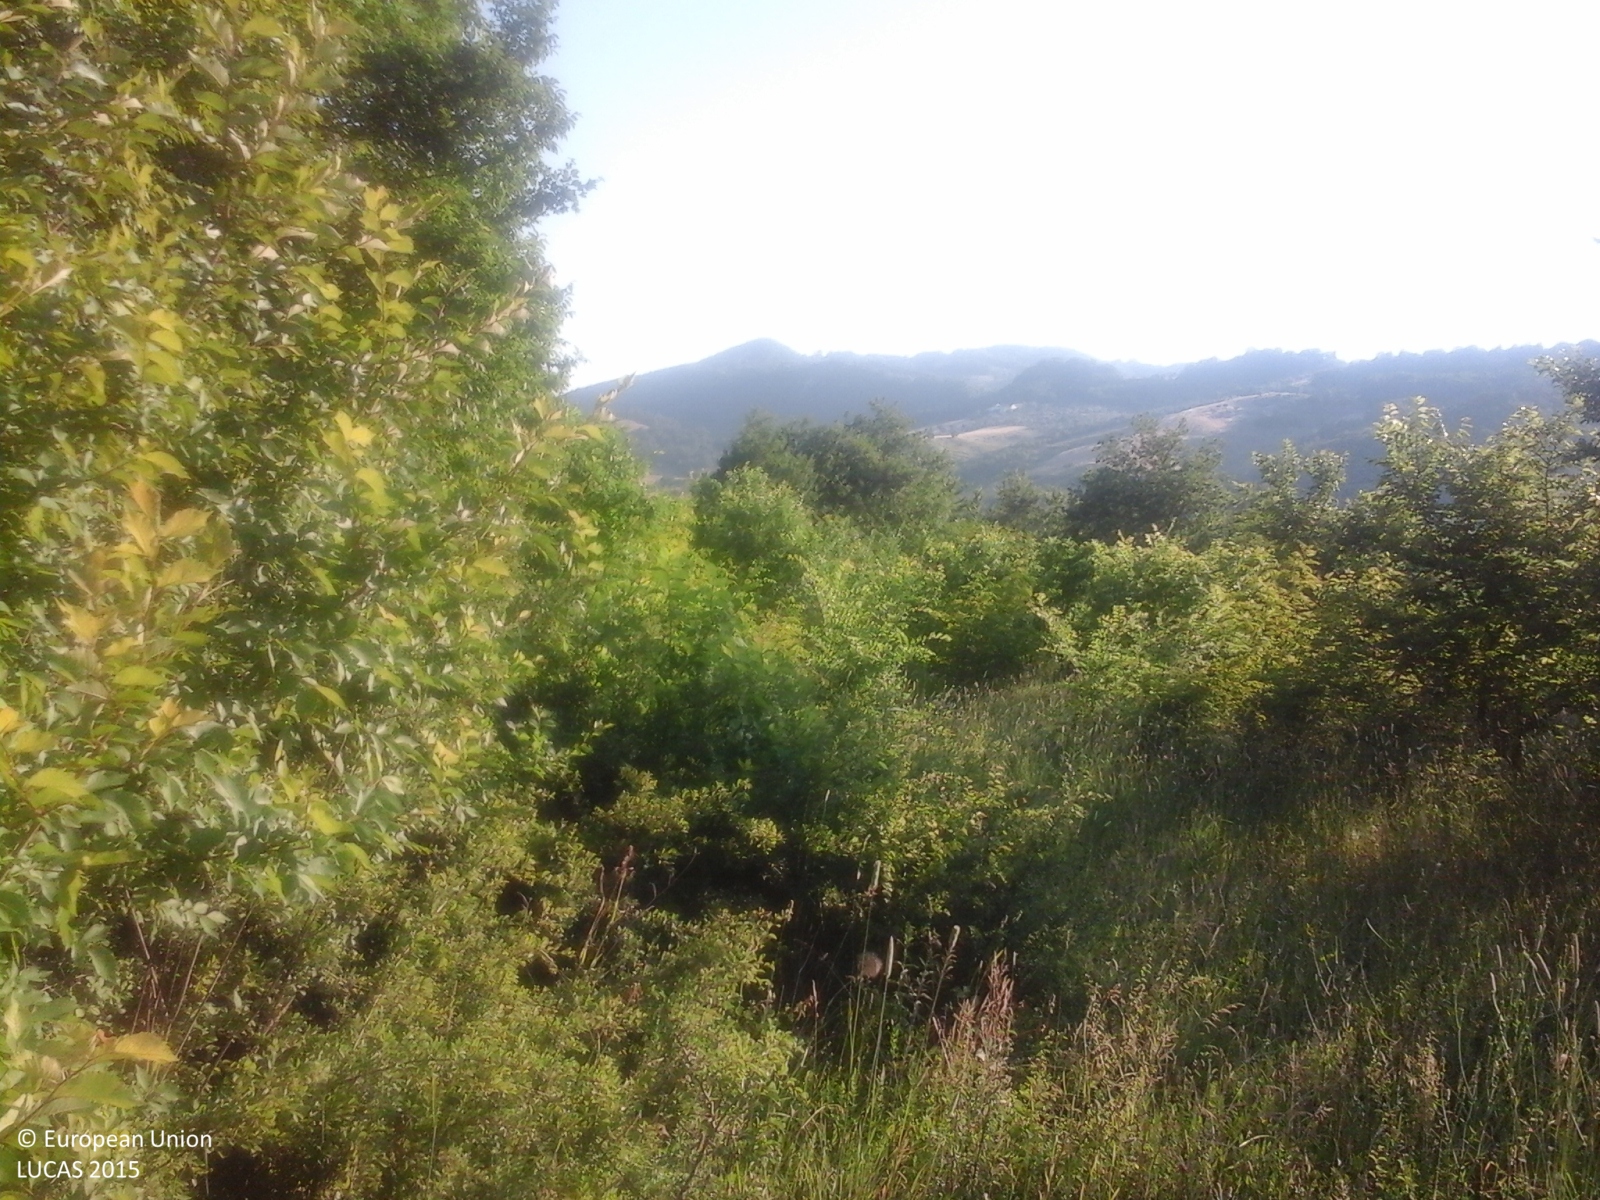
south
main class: Grassland
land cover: Grassland without tree/shrub cover
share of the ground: 25 - 50 %
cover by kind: herbaceous plants 95 %, shrubs 5 %
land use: Abandoned areas
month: June
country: IT
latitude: 42.0362
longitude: 14.3468
